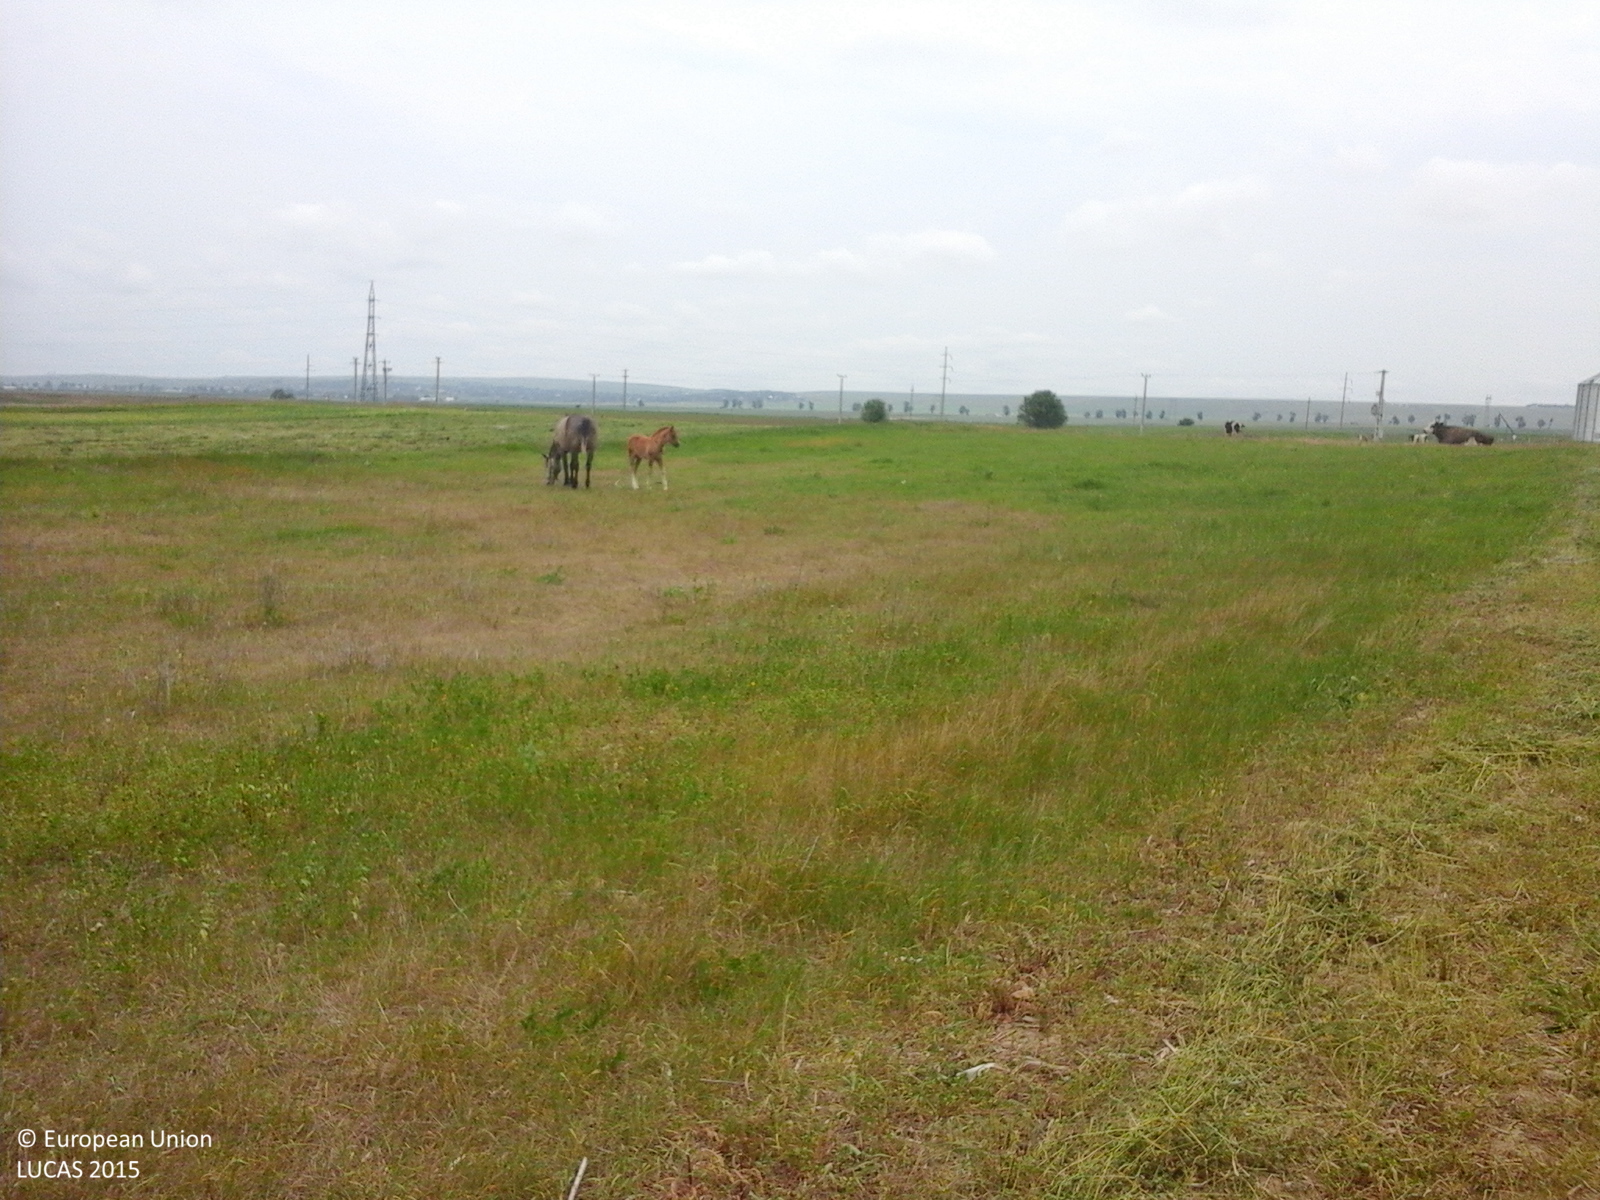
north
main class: Cropland
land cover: Other leguminous and mixtures for fodder
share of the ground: > 75 %
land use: Agriculture (excluding fallow land and kitchen gardens)
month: June
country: RO
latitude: 47.0884
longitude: 26.6756
